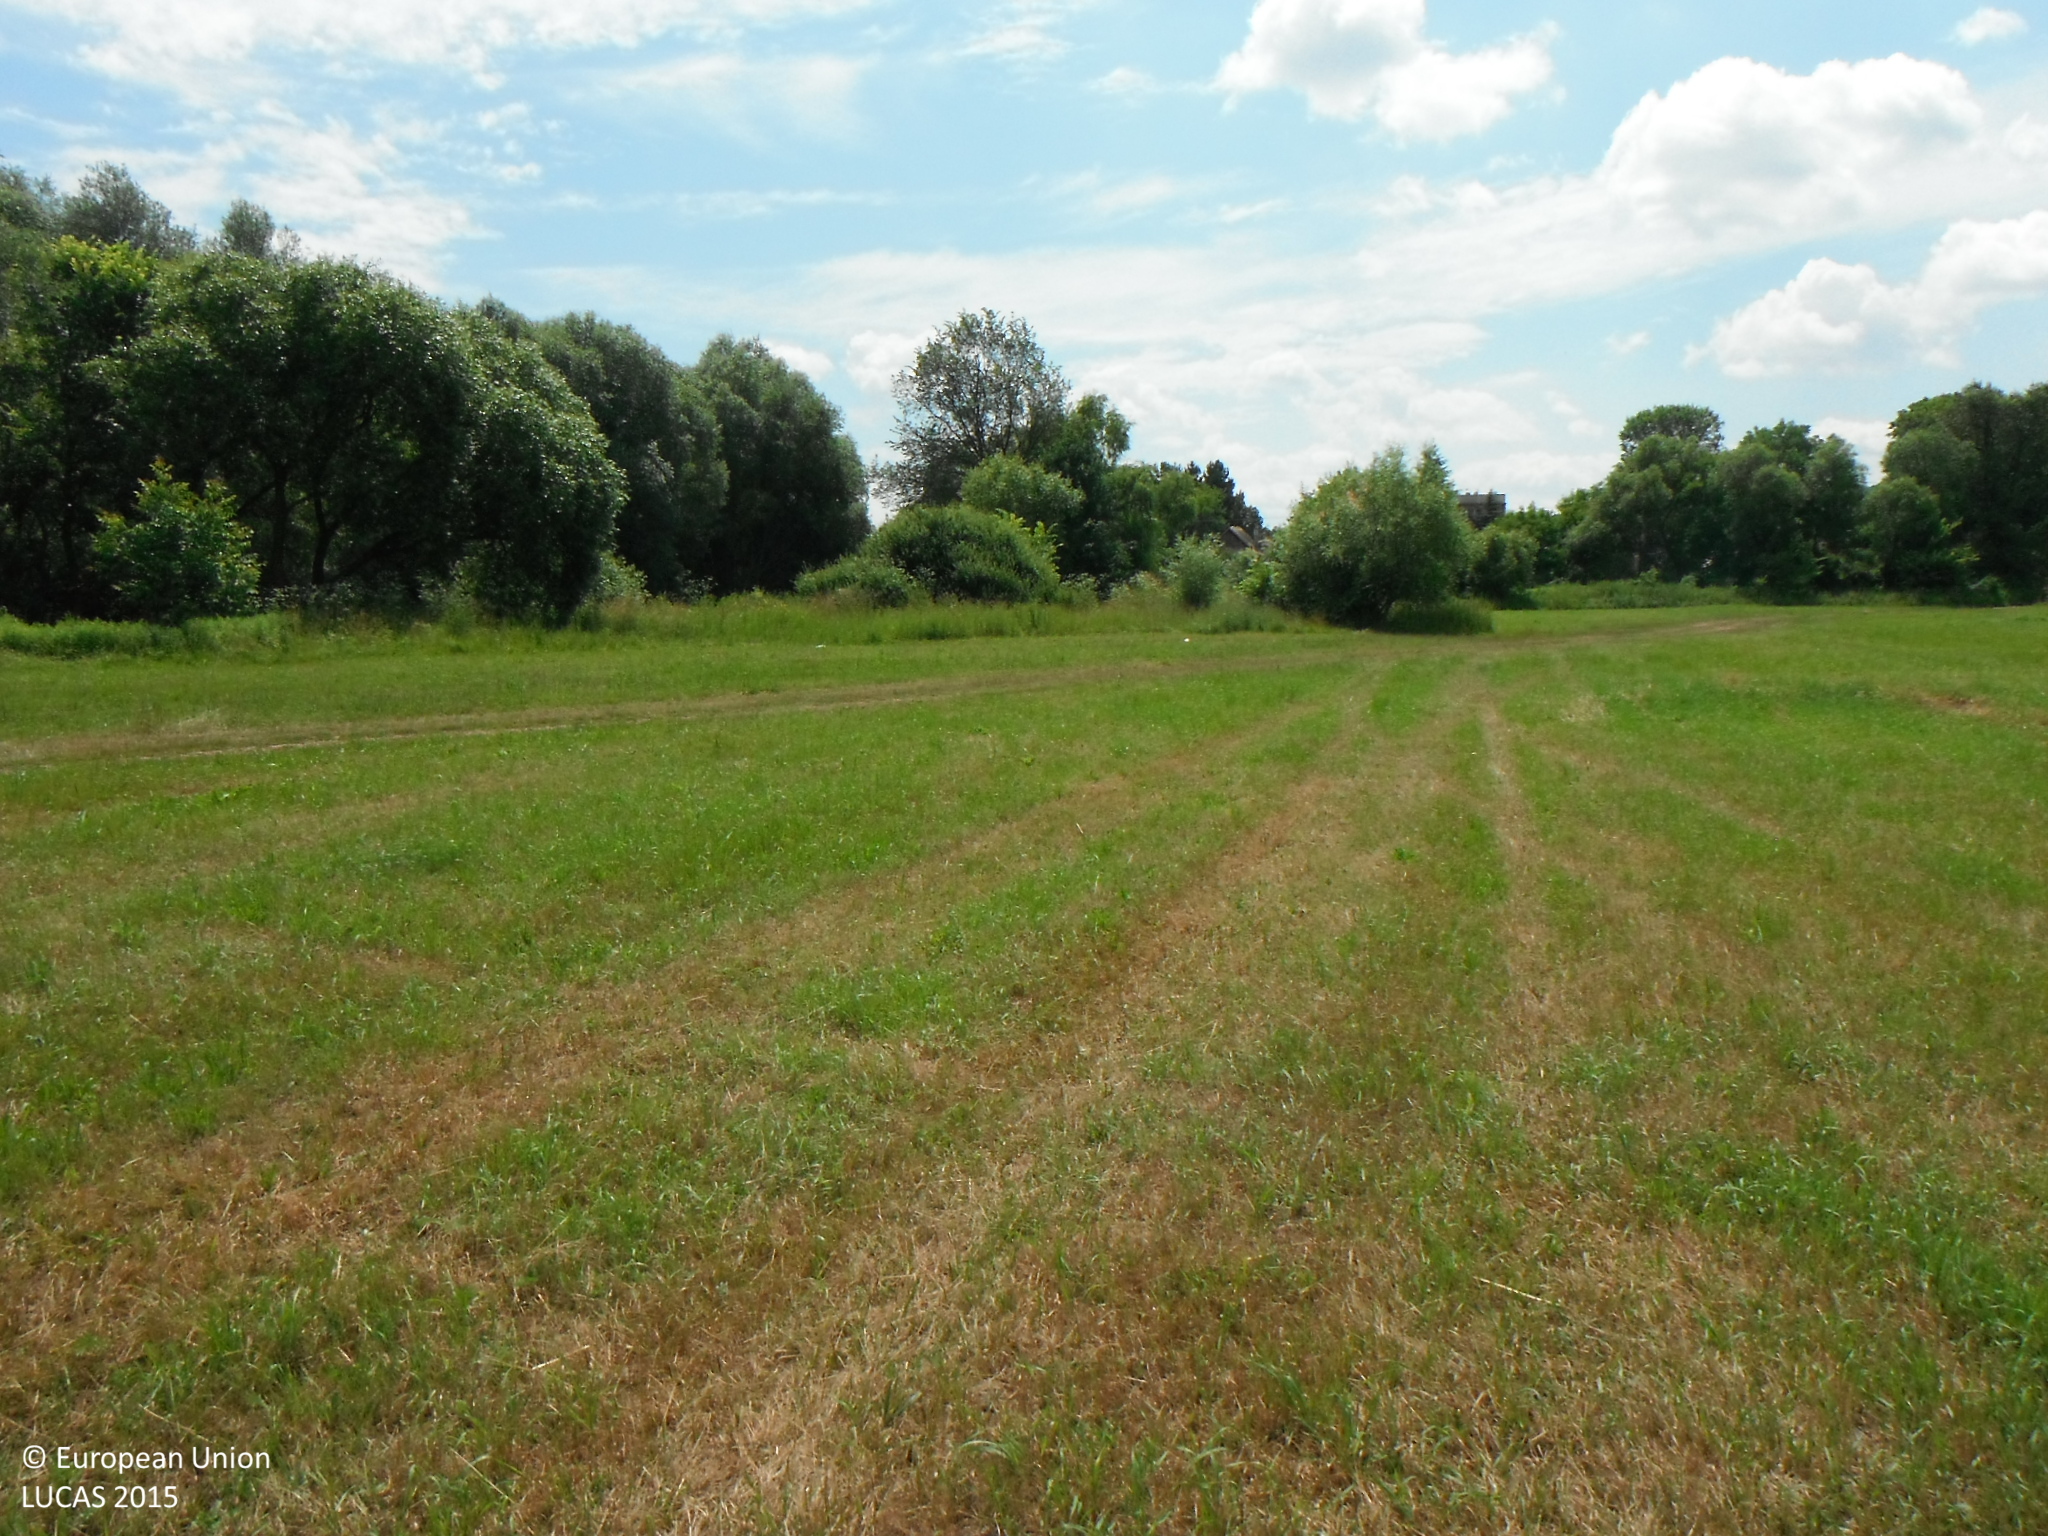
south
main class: Grassland
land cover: Grassland without tree/shrub cover
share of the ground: > 75 %
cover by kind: herbaceous plants 100 %
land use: Agriculture (excluding fallow land and kitchen gardens)
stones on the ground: < 10 %
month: June
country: SK
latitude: 48.1744
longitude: 19.5047
